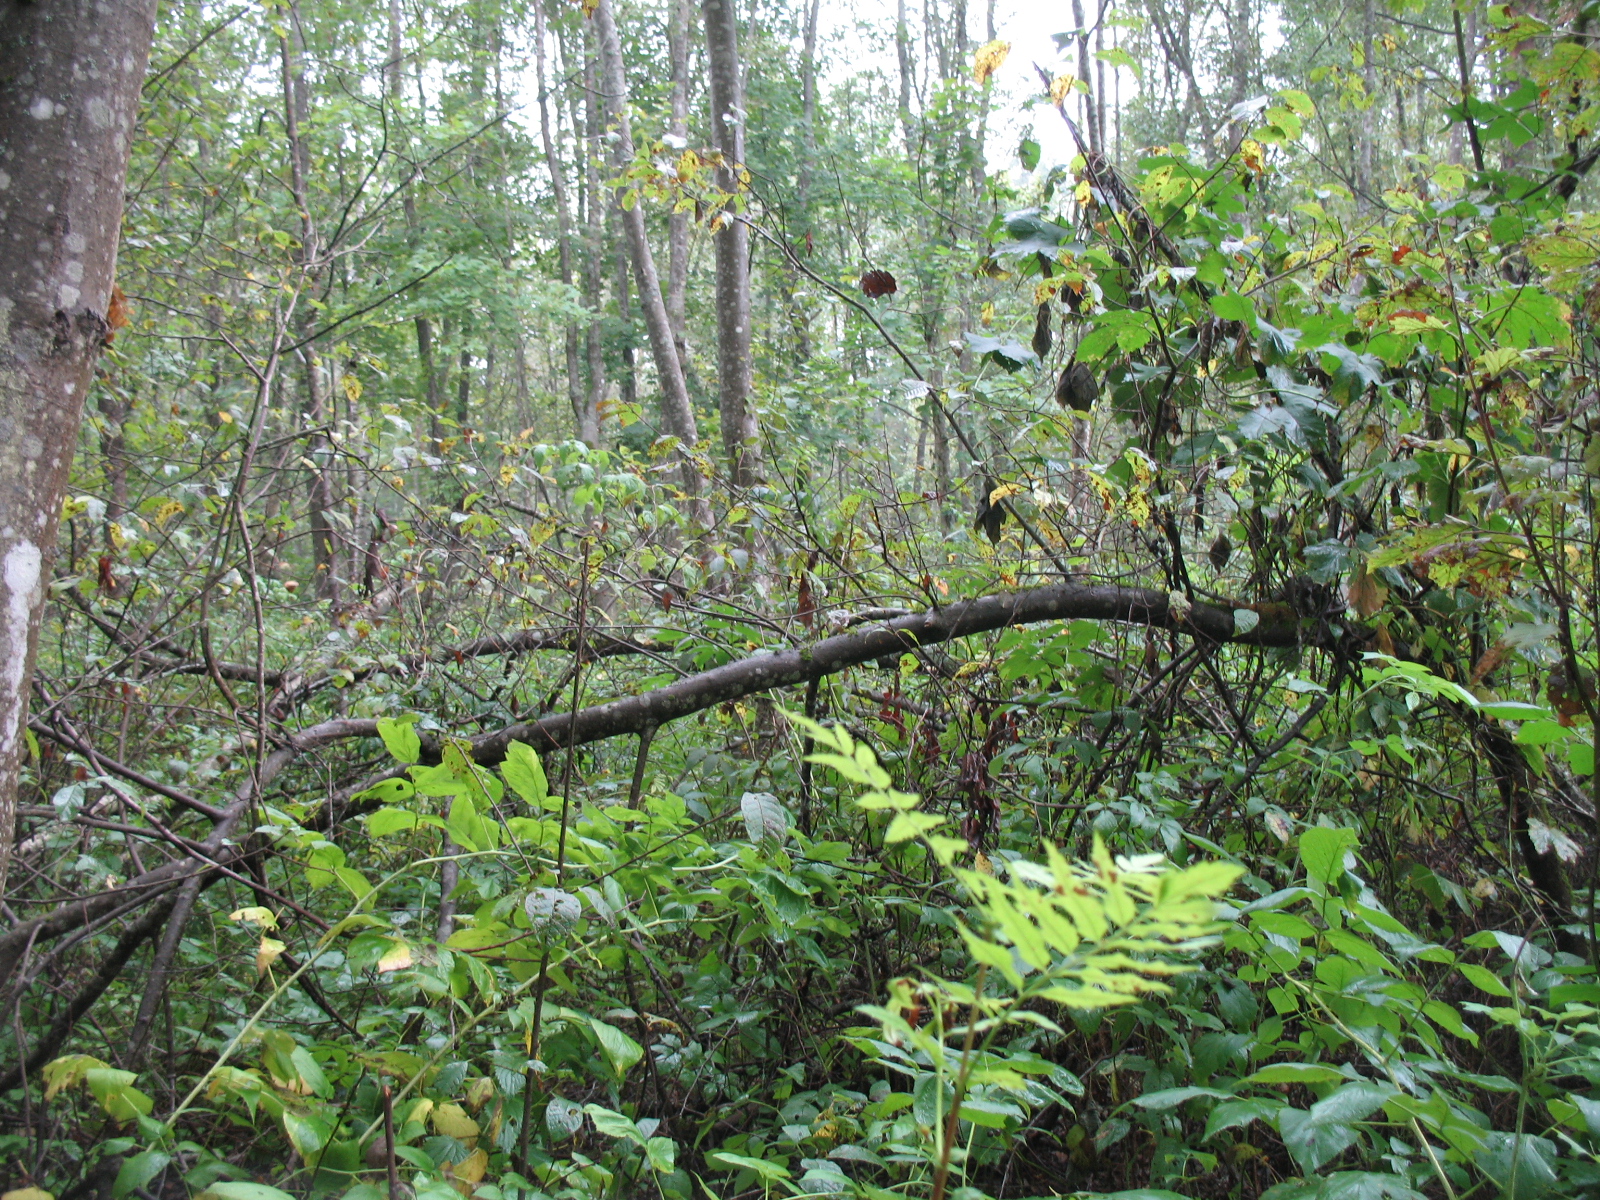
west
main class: Woodland
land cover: Broadleaved woodland
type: non-riverine alder, birch or aspen forest
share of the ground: > 75 %
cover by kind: broadleaved forest trees 75 %, shrubs 20 %, herbaceous plants 5 %
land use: Forestry
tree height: > 5 m
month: September
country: LV
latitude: 56.0903
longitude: 26.1641
